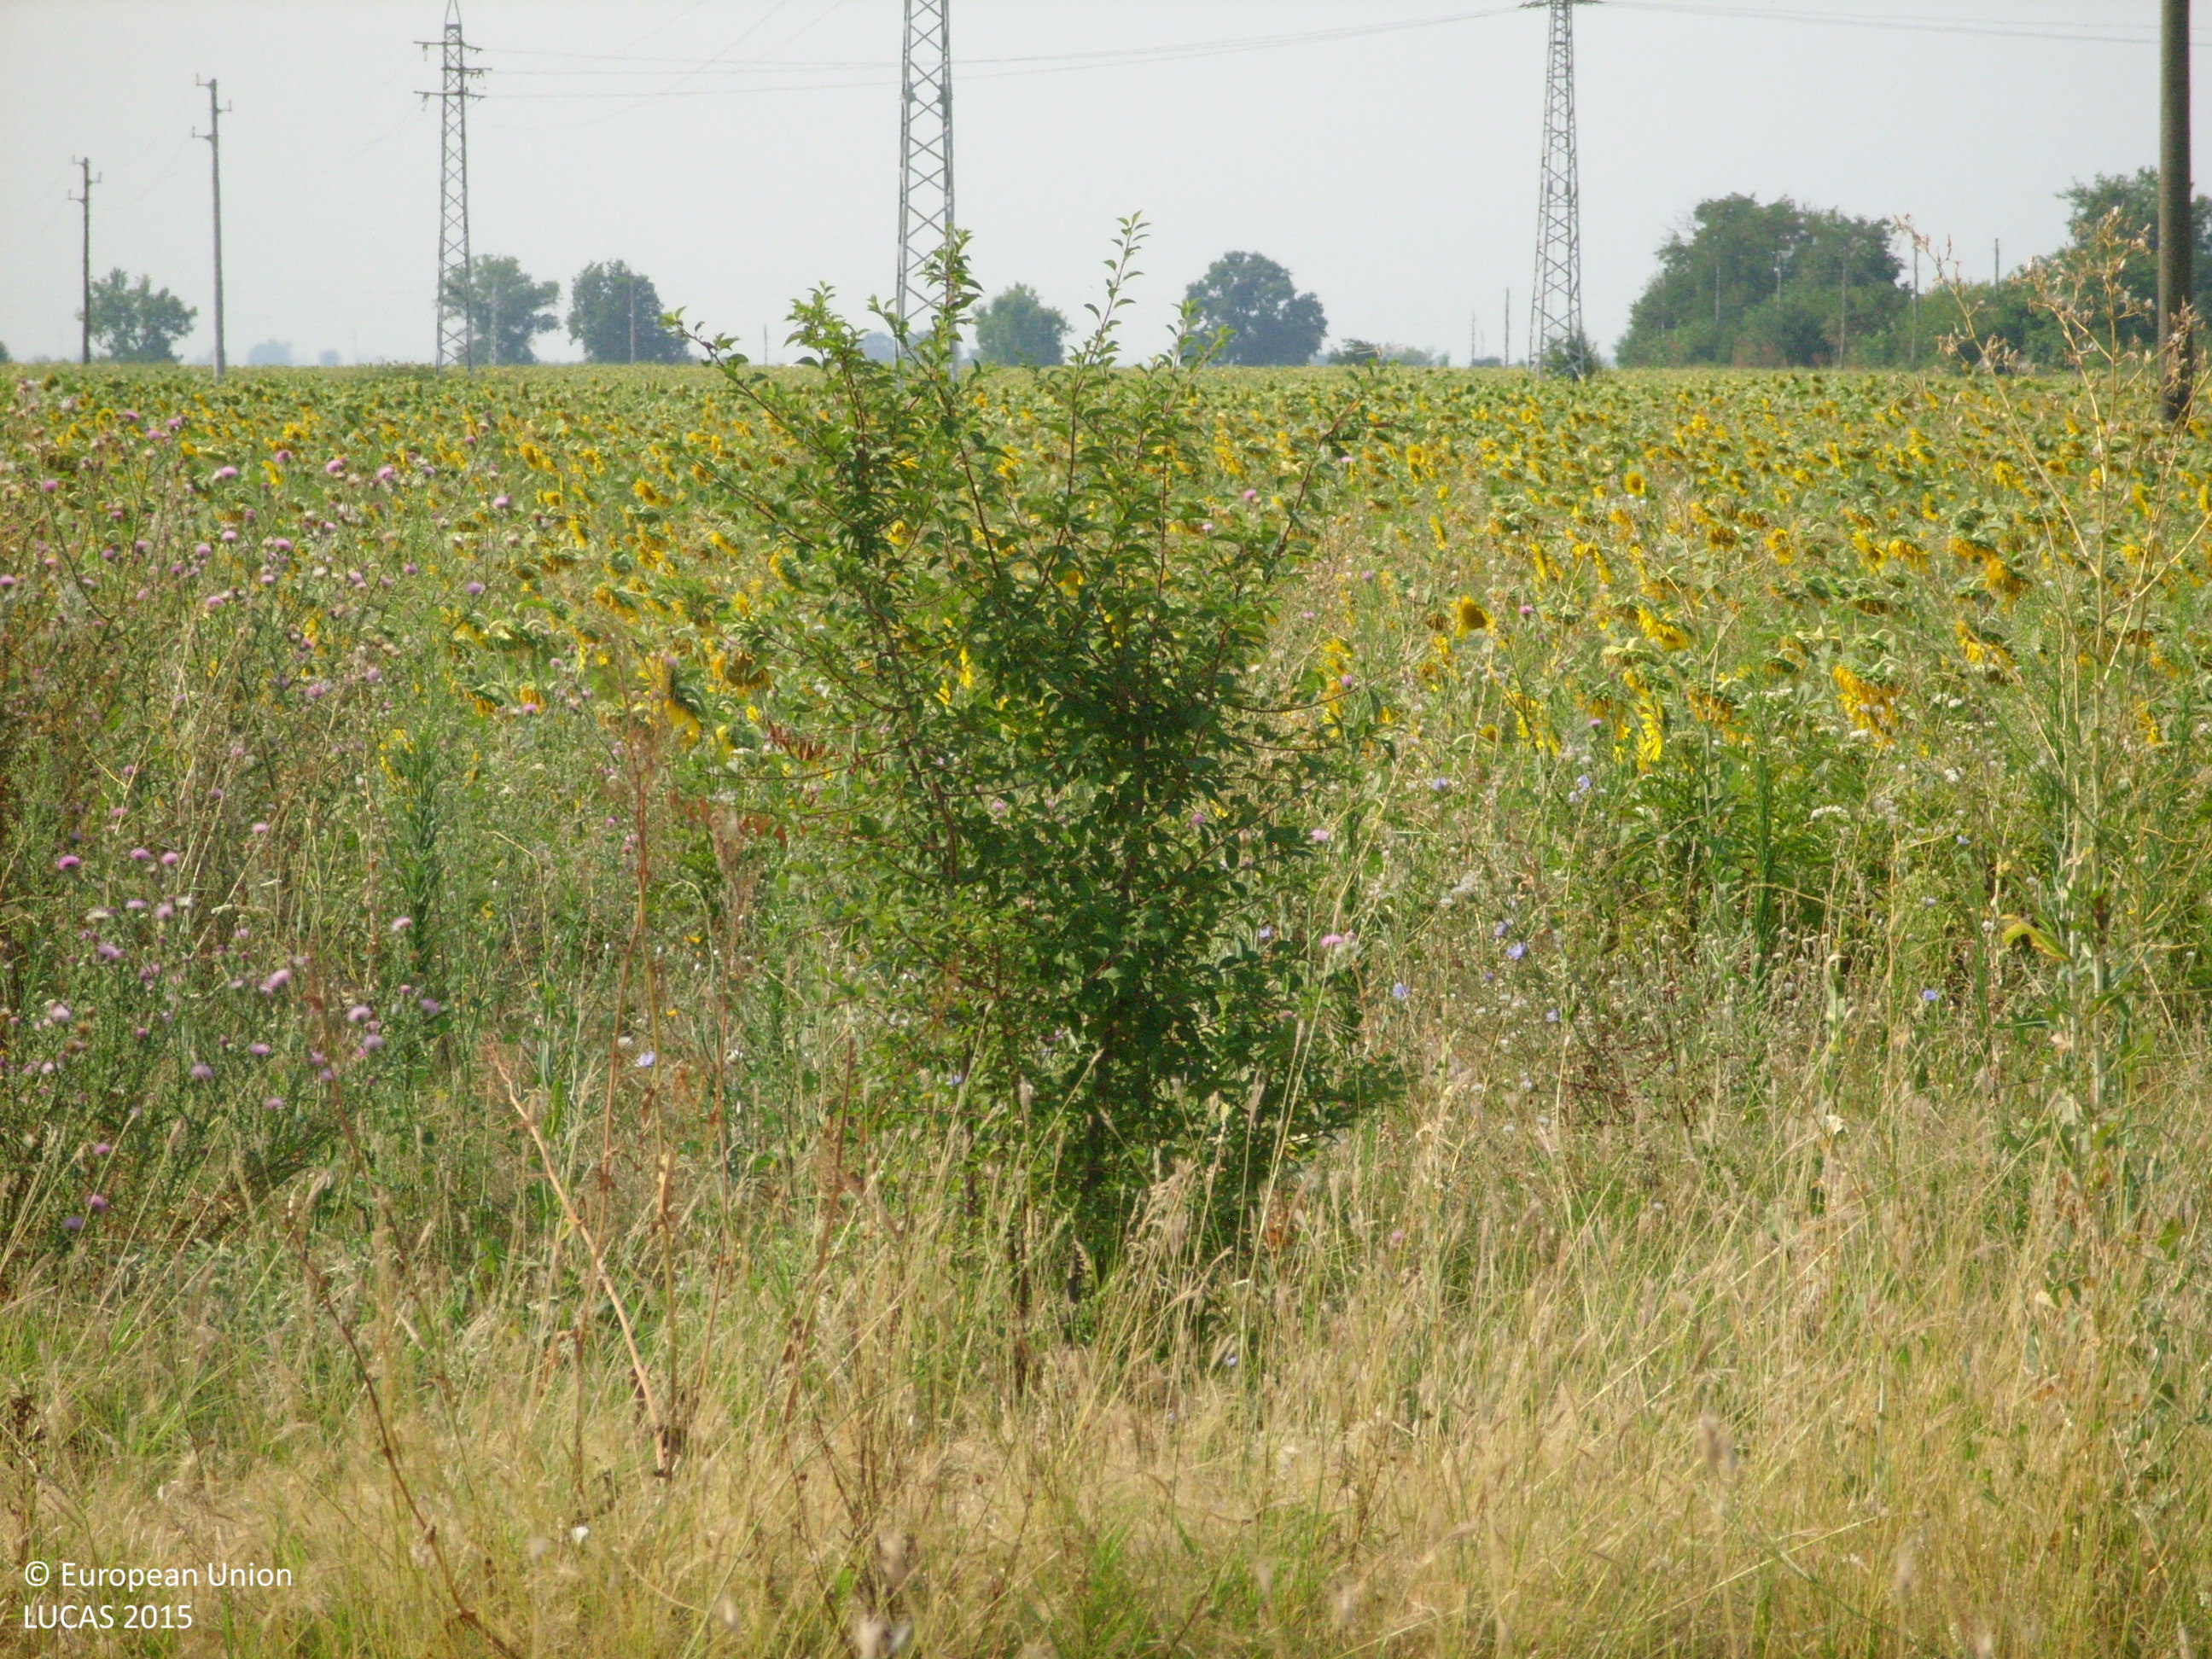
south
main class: Cropland
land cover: Sunflower
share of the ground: > 75 %
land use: Agriculture (excluding fallow land and kitchen gardens)
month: July
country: BG
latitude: 42.2978
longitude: 24.6431
